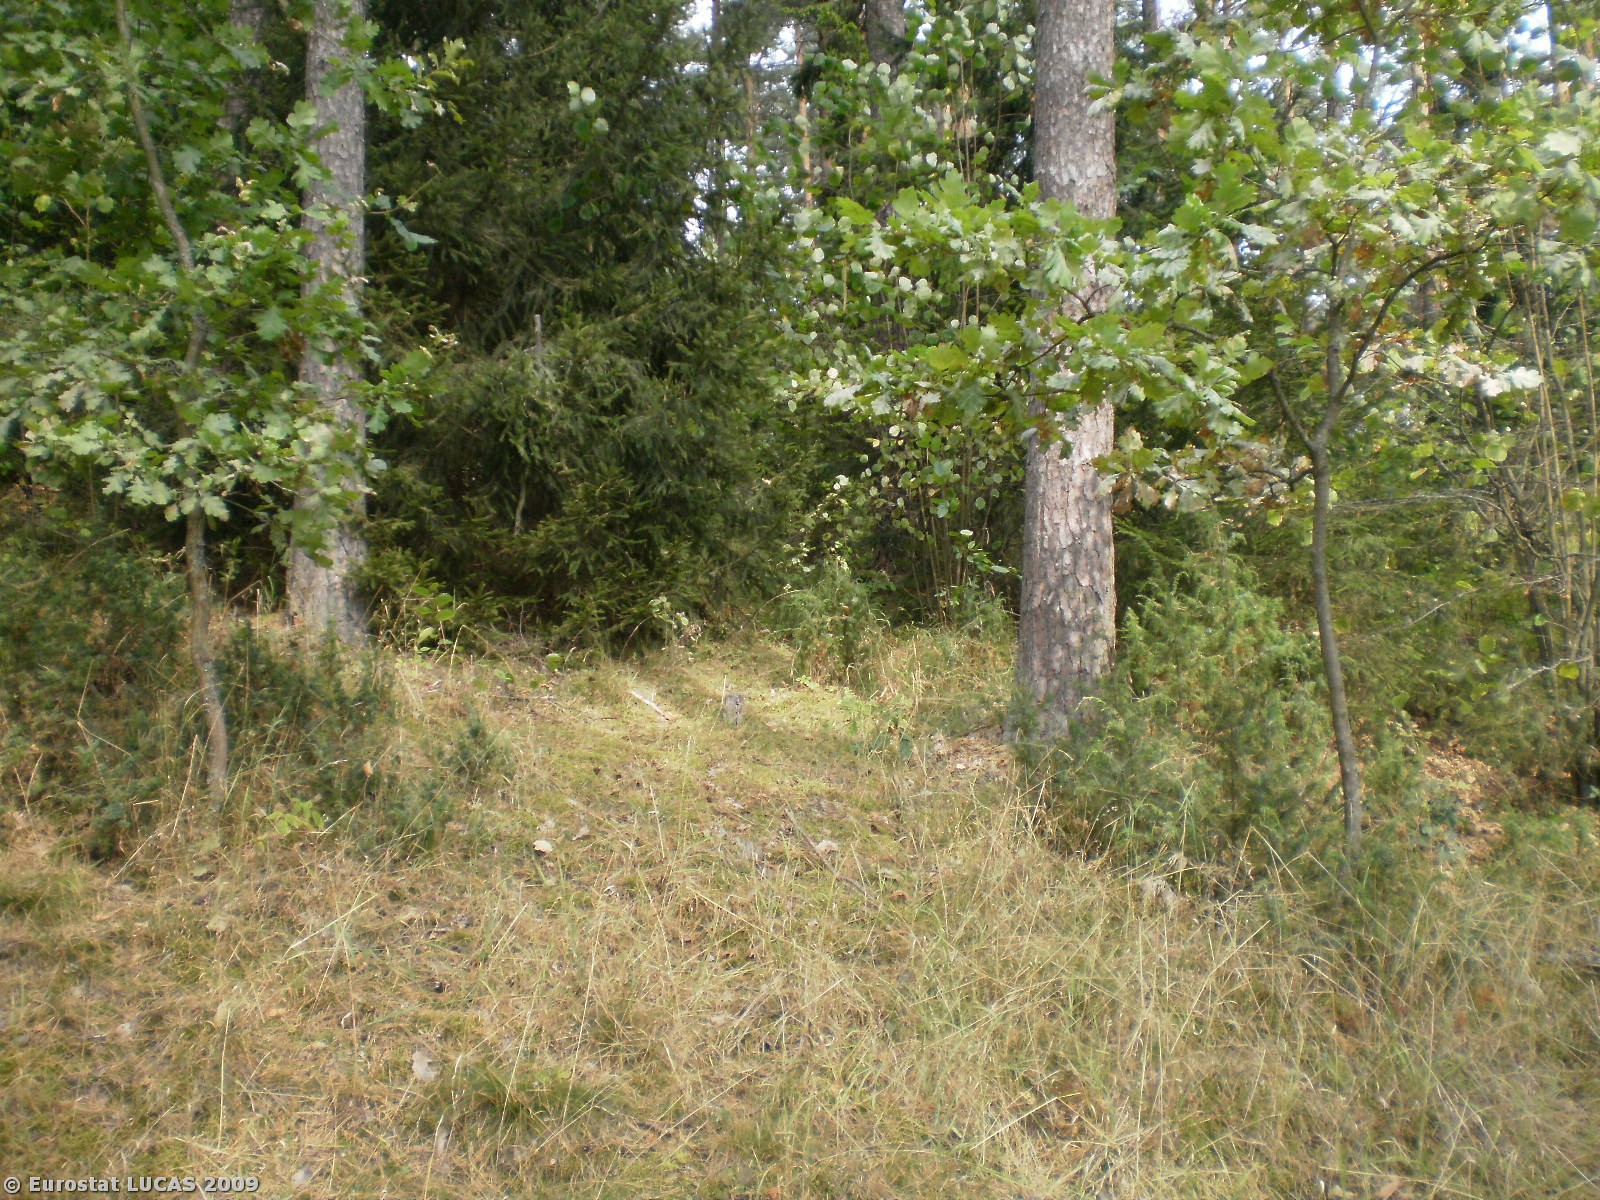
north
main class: Woodland
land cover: Coniferous woodland
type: hemiboreal forest and nemoral coniferous forest and mixed broadleaved-coniferous forest
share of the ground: 50 - 75 %
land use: Forestry
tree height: > 5 m
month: September
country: PL
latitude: 53.7156
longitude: 21.3976
